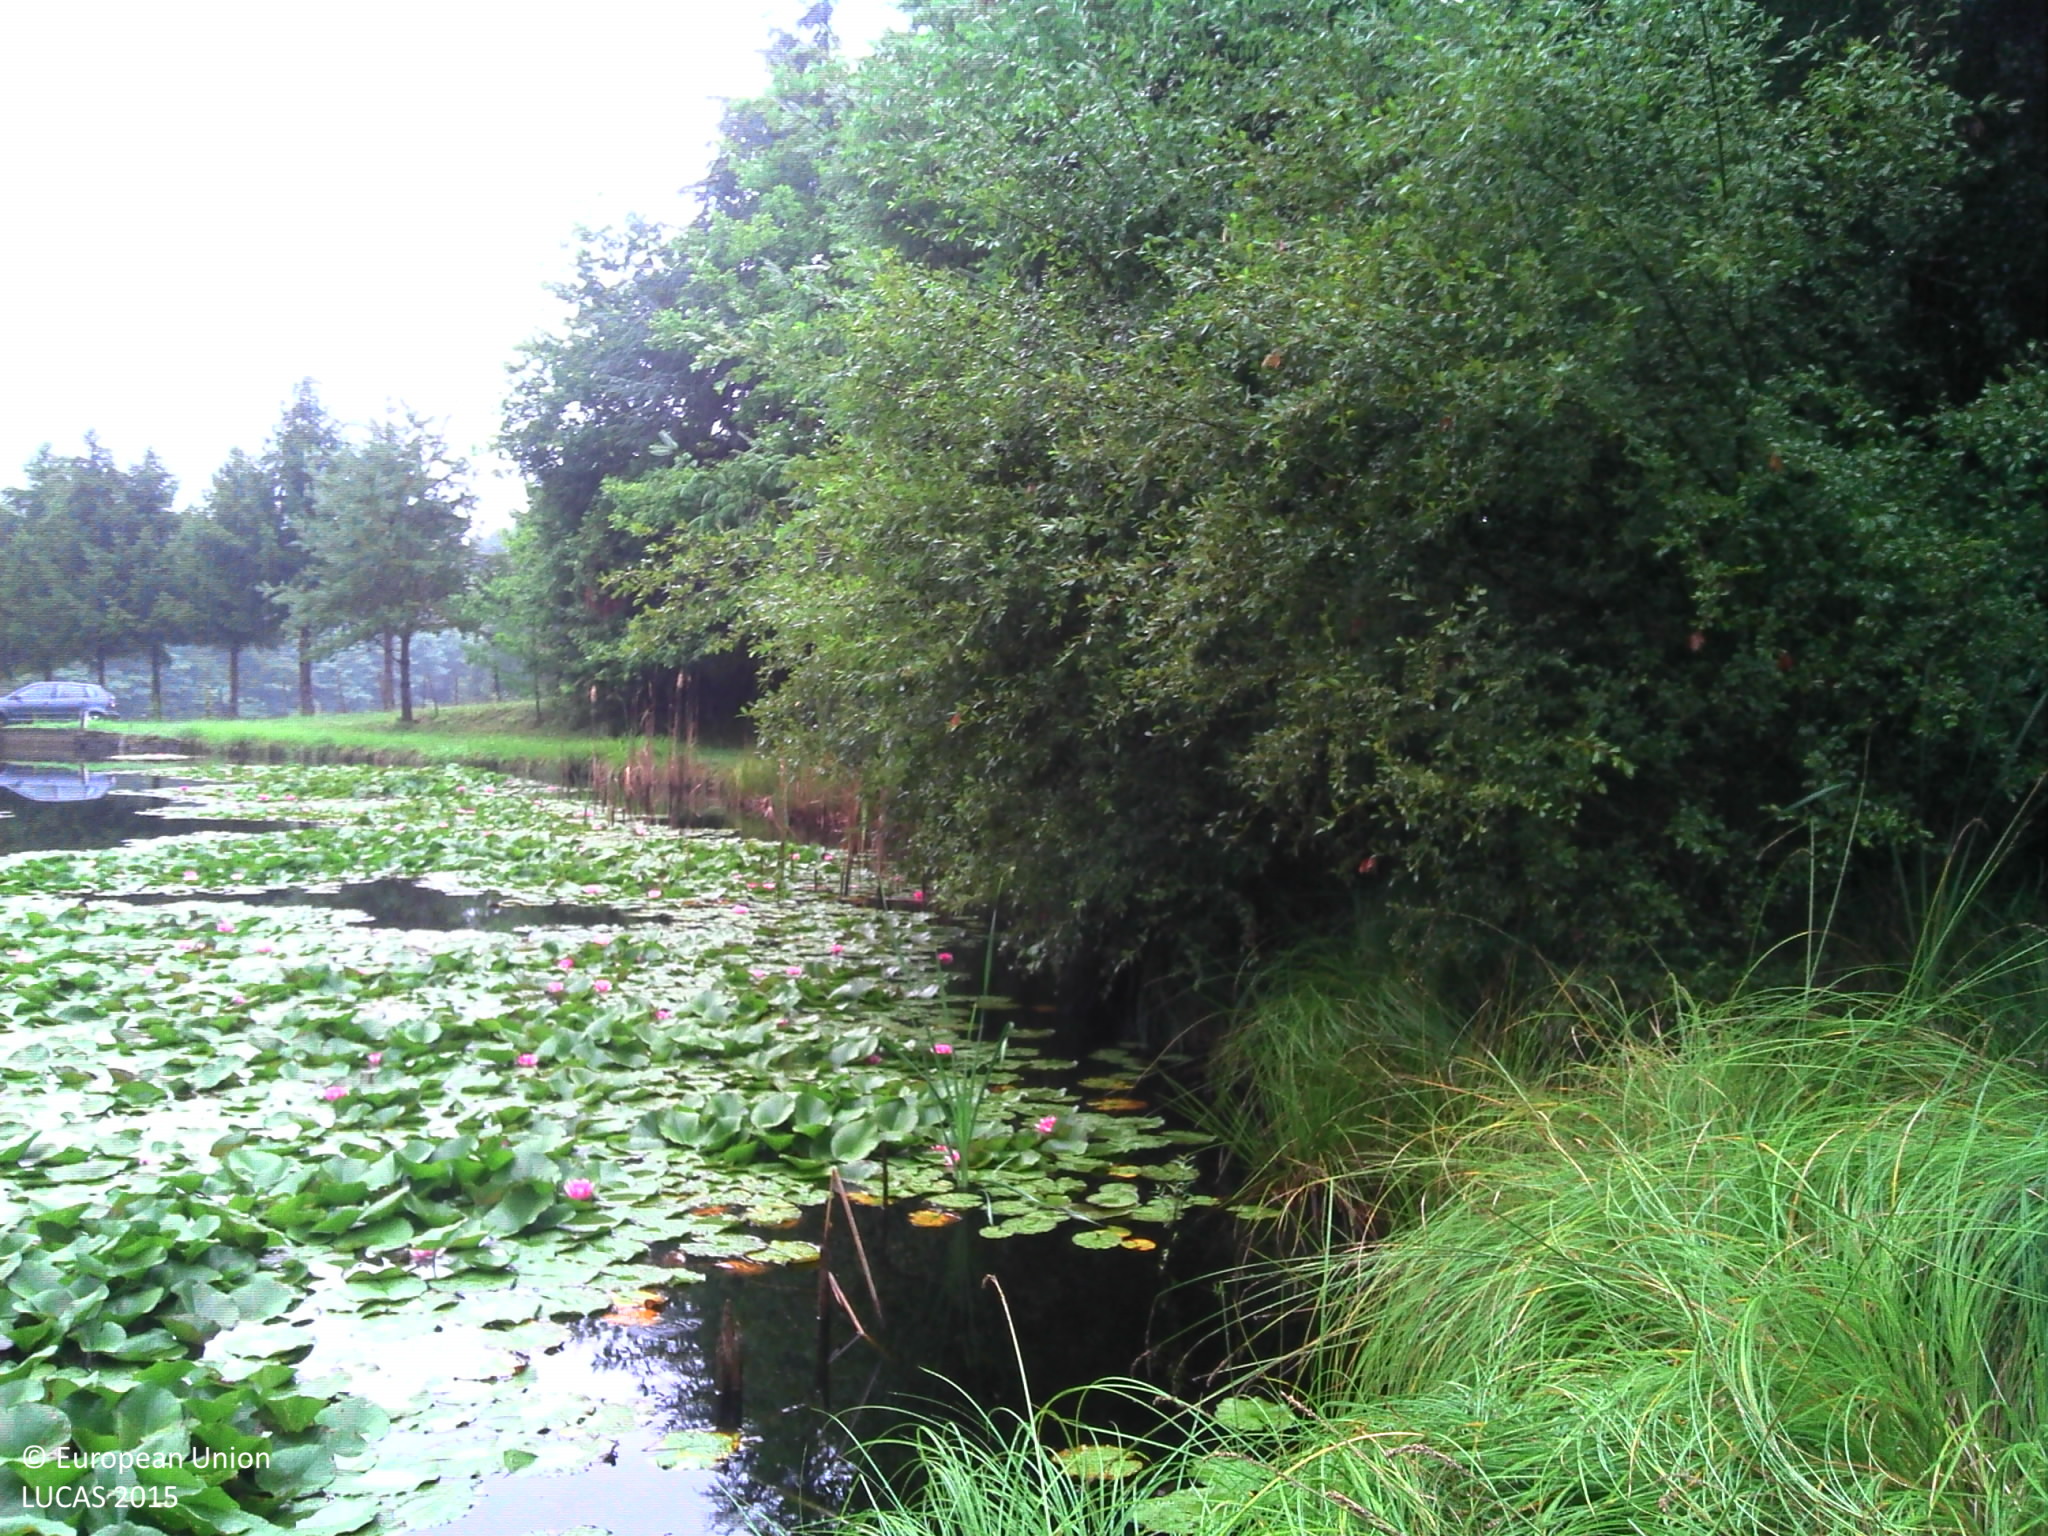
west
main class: Grassland
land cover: Grassland without tree/shrub cover
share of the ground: > 75 %
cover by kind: herbaceous plants 95 %, shrubs 5 %
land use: Forestry
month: August
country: FR
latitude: 45.5489
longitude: 0.7277
